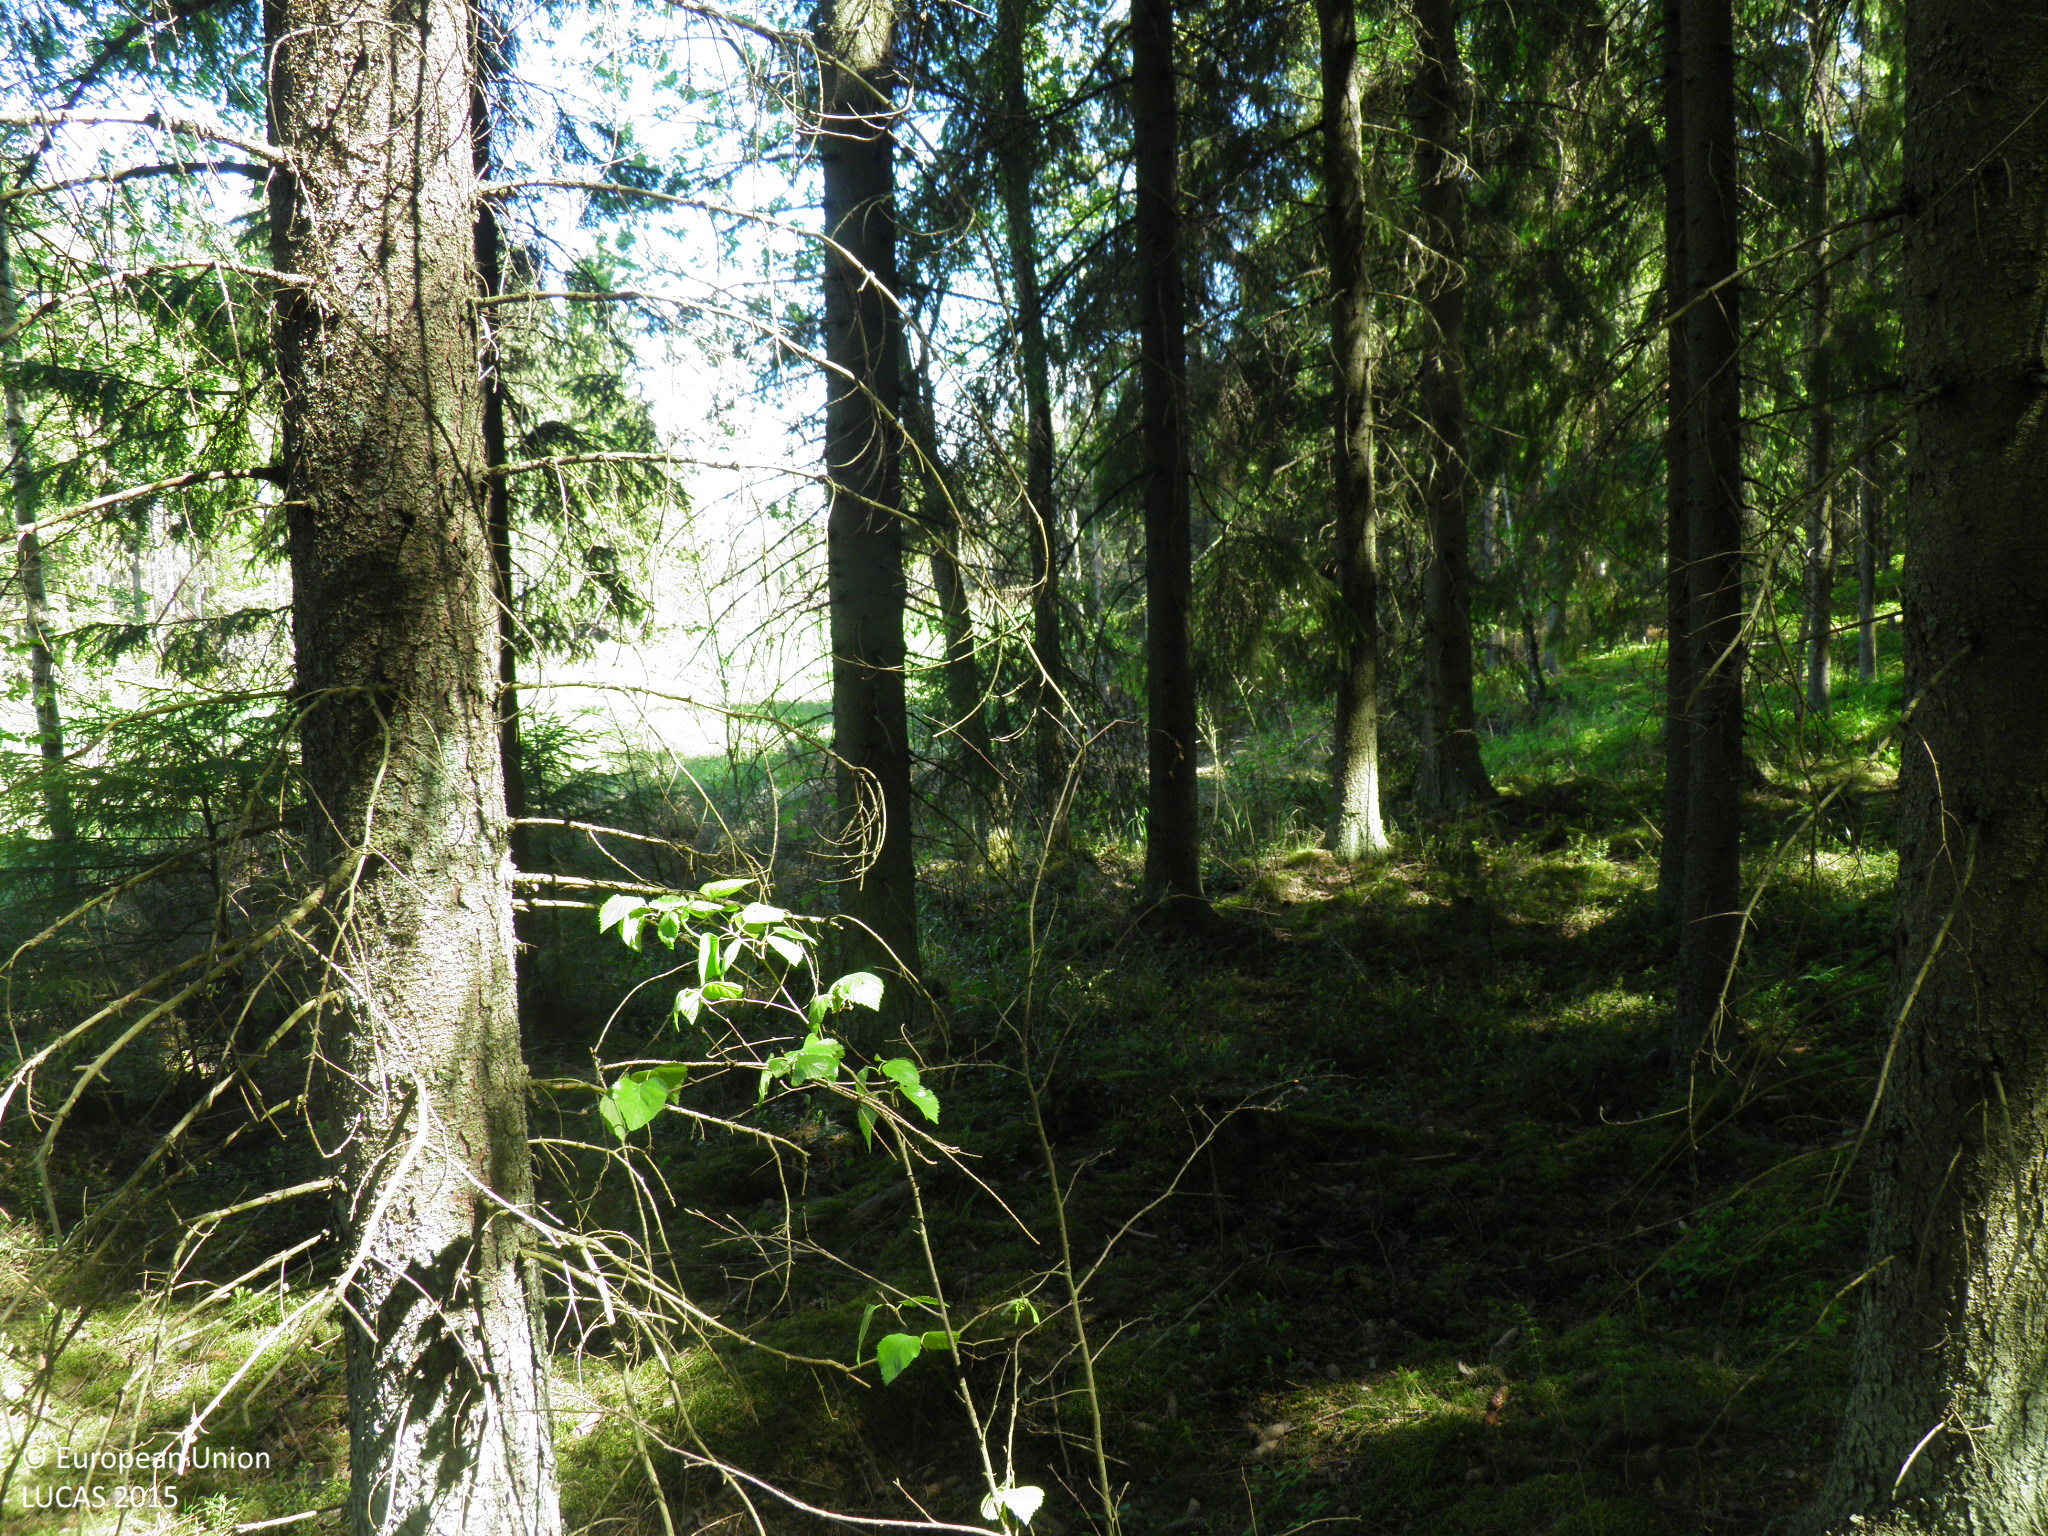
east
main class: Woodland
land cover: Spruce dominated coniferous woodland
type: boreal forest
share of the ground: > 75 %
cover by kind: coniferous forest trees 90 %, broadleaved forest trees 5 %, lichens and mosses 5 %
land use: Forestry
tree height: > 5 m
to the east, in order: Spruce dominated coniferous woodland; Ditches and canals; Grassland without tree/shrub cover; Ditches and canals; Spruce dominated coniferous woodland; Tracks; Spruce dominated coniferous woodland
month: June
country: FI
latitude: 60.5294
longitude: 22.1461
